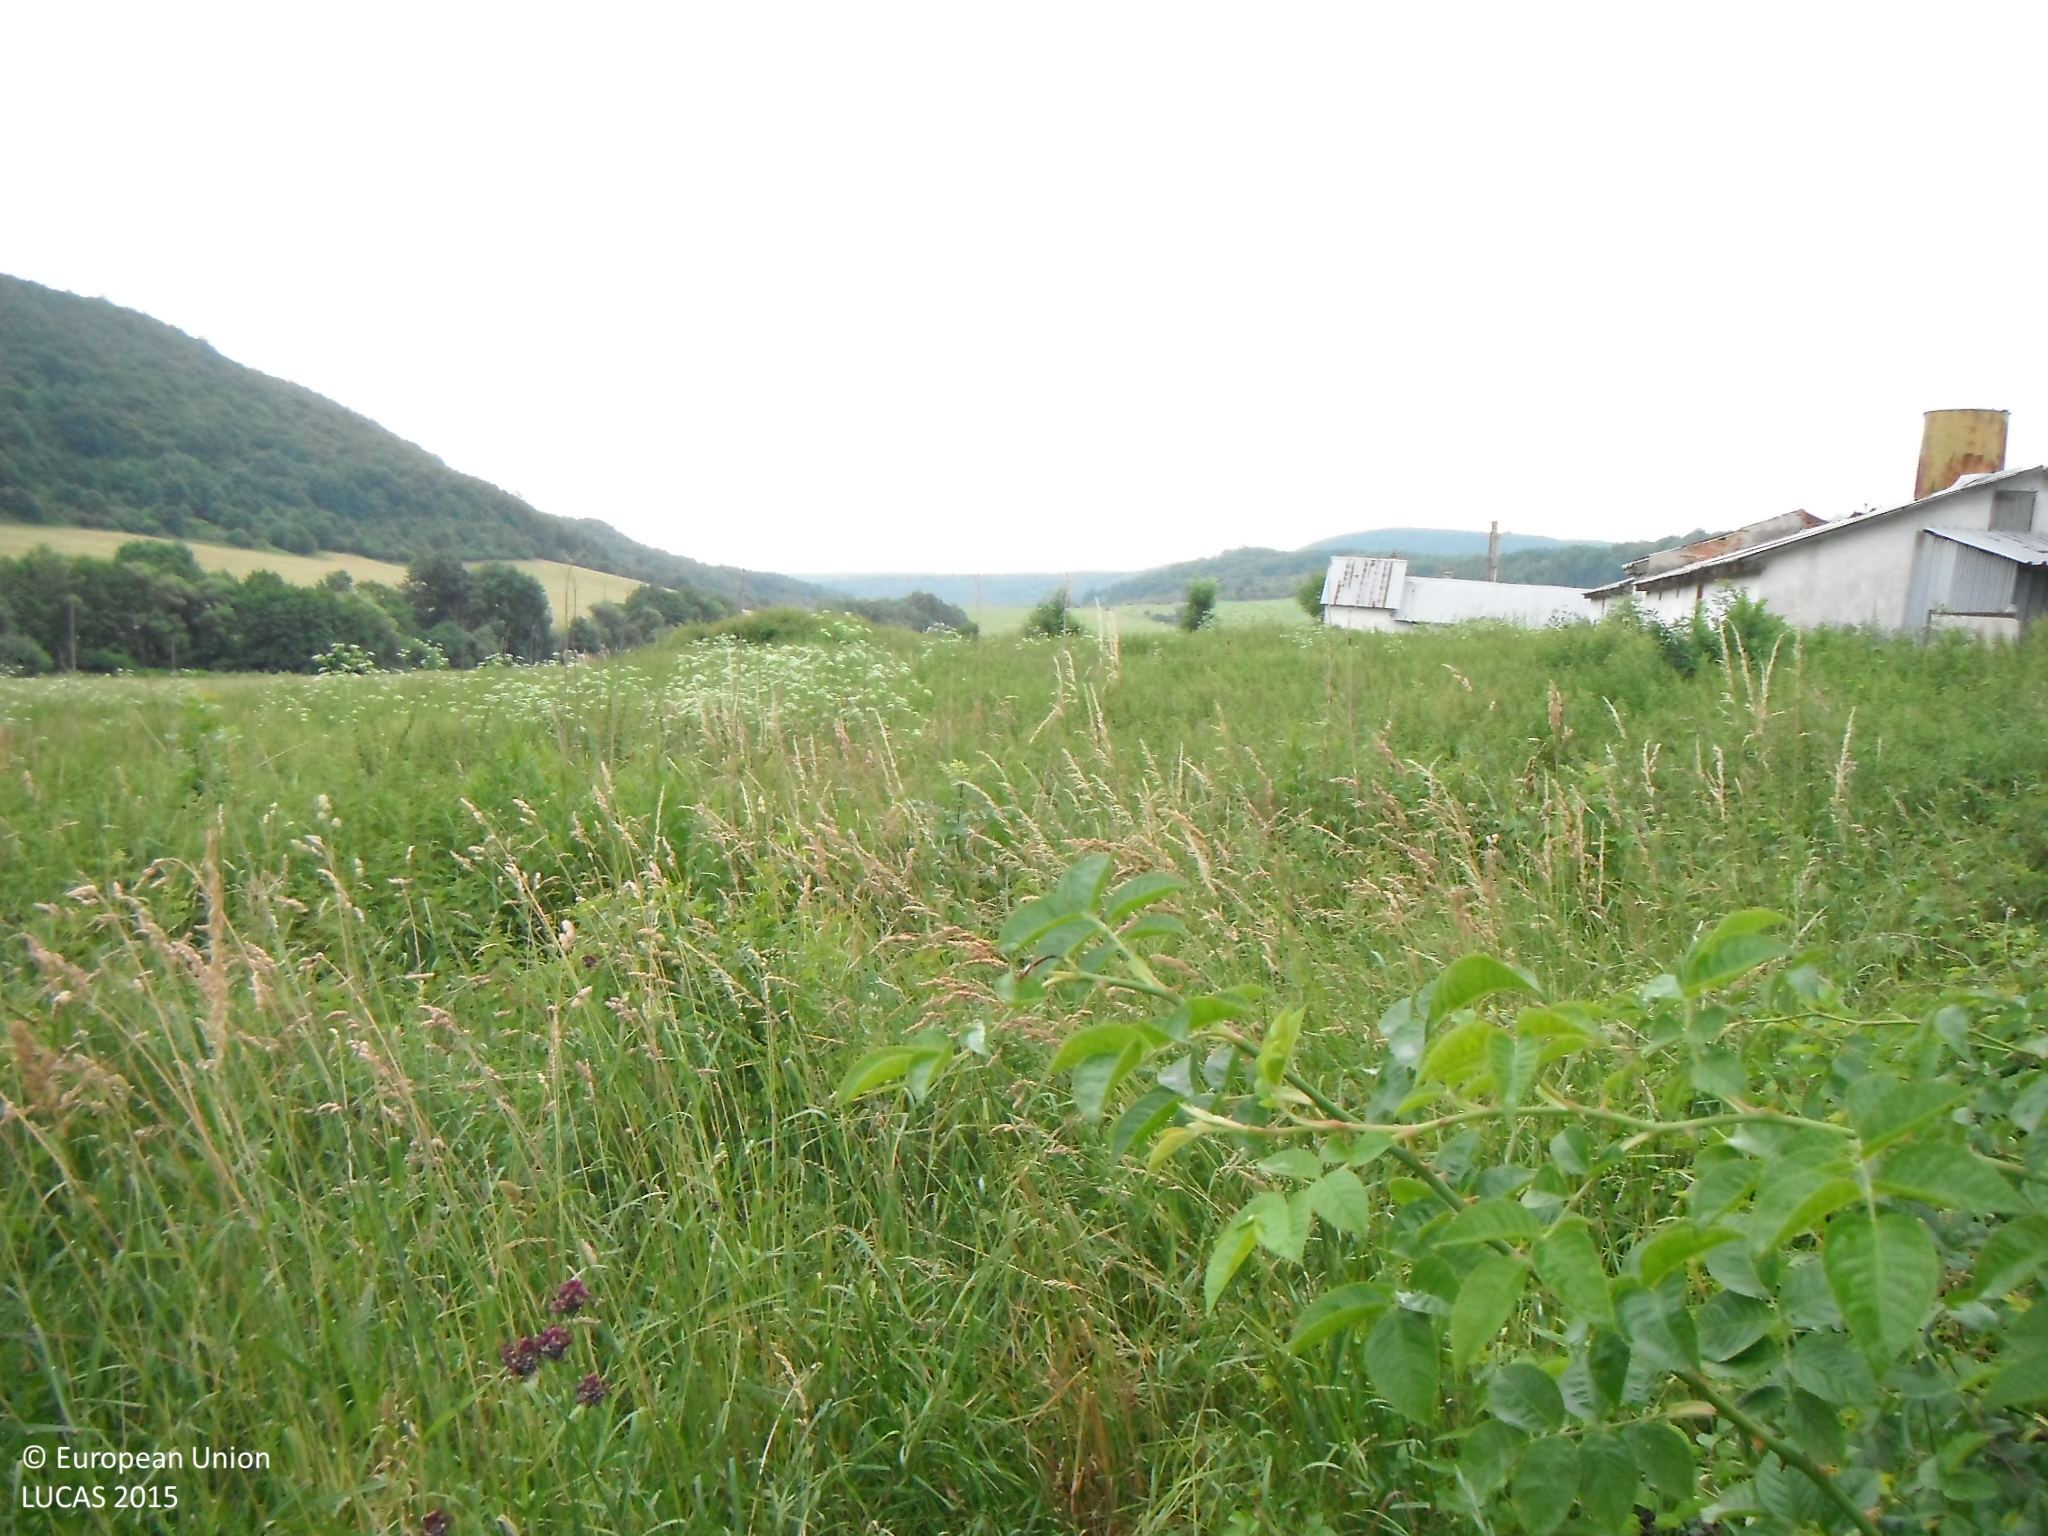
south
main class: Grassland
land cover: Grassland with sparse tree/shrub cover
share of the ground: > 75 %
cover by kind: herbaceous plants 85 %, shrubs 10 %, broadleaved forest trees 5 %
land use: Semi-natural and natural areas not in use
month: June
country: SK
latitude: 48.4903
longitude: 20.0293
